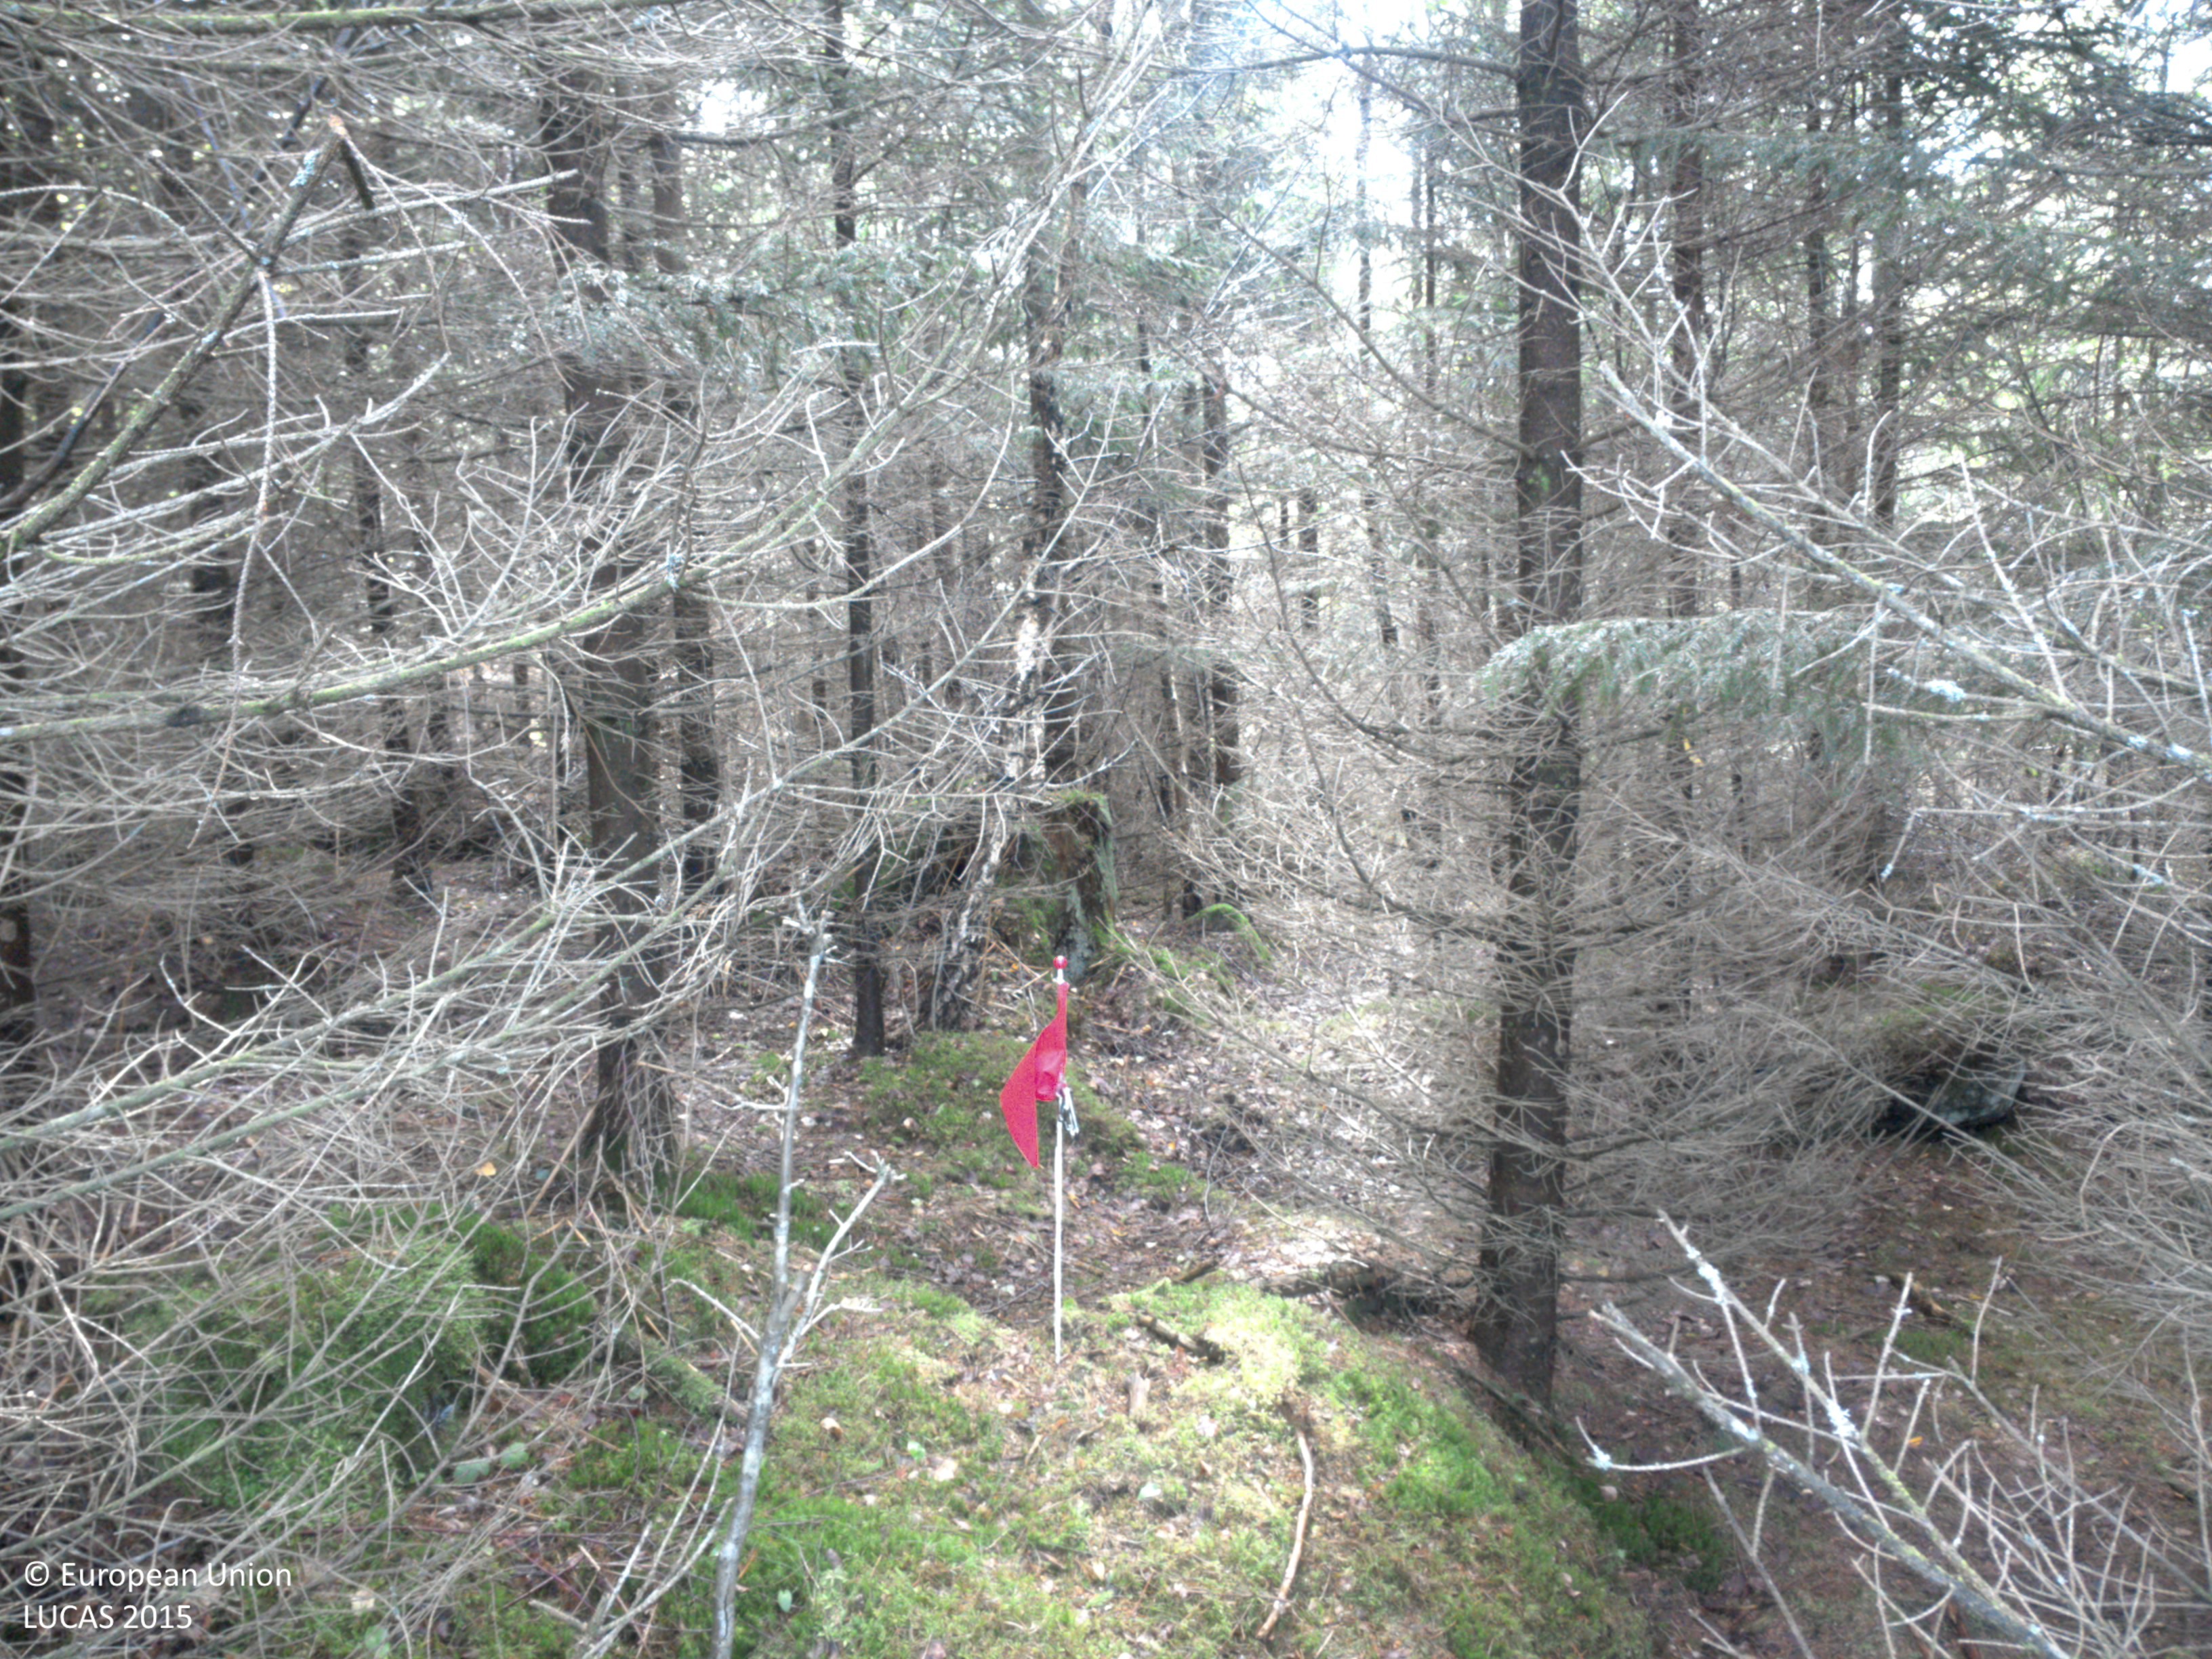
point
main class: Woodland
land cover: Spruce dominated coniferous woodland
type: boreal forest
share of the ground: > 75 %
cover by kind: coniferous forest trees 80 %, shrubs 20 %
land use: Forestry
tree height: > 5 m
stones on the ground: 10 - 25 %
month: July
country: SE
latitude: 58.1329
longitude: 11.9832
